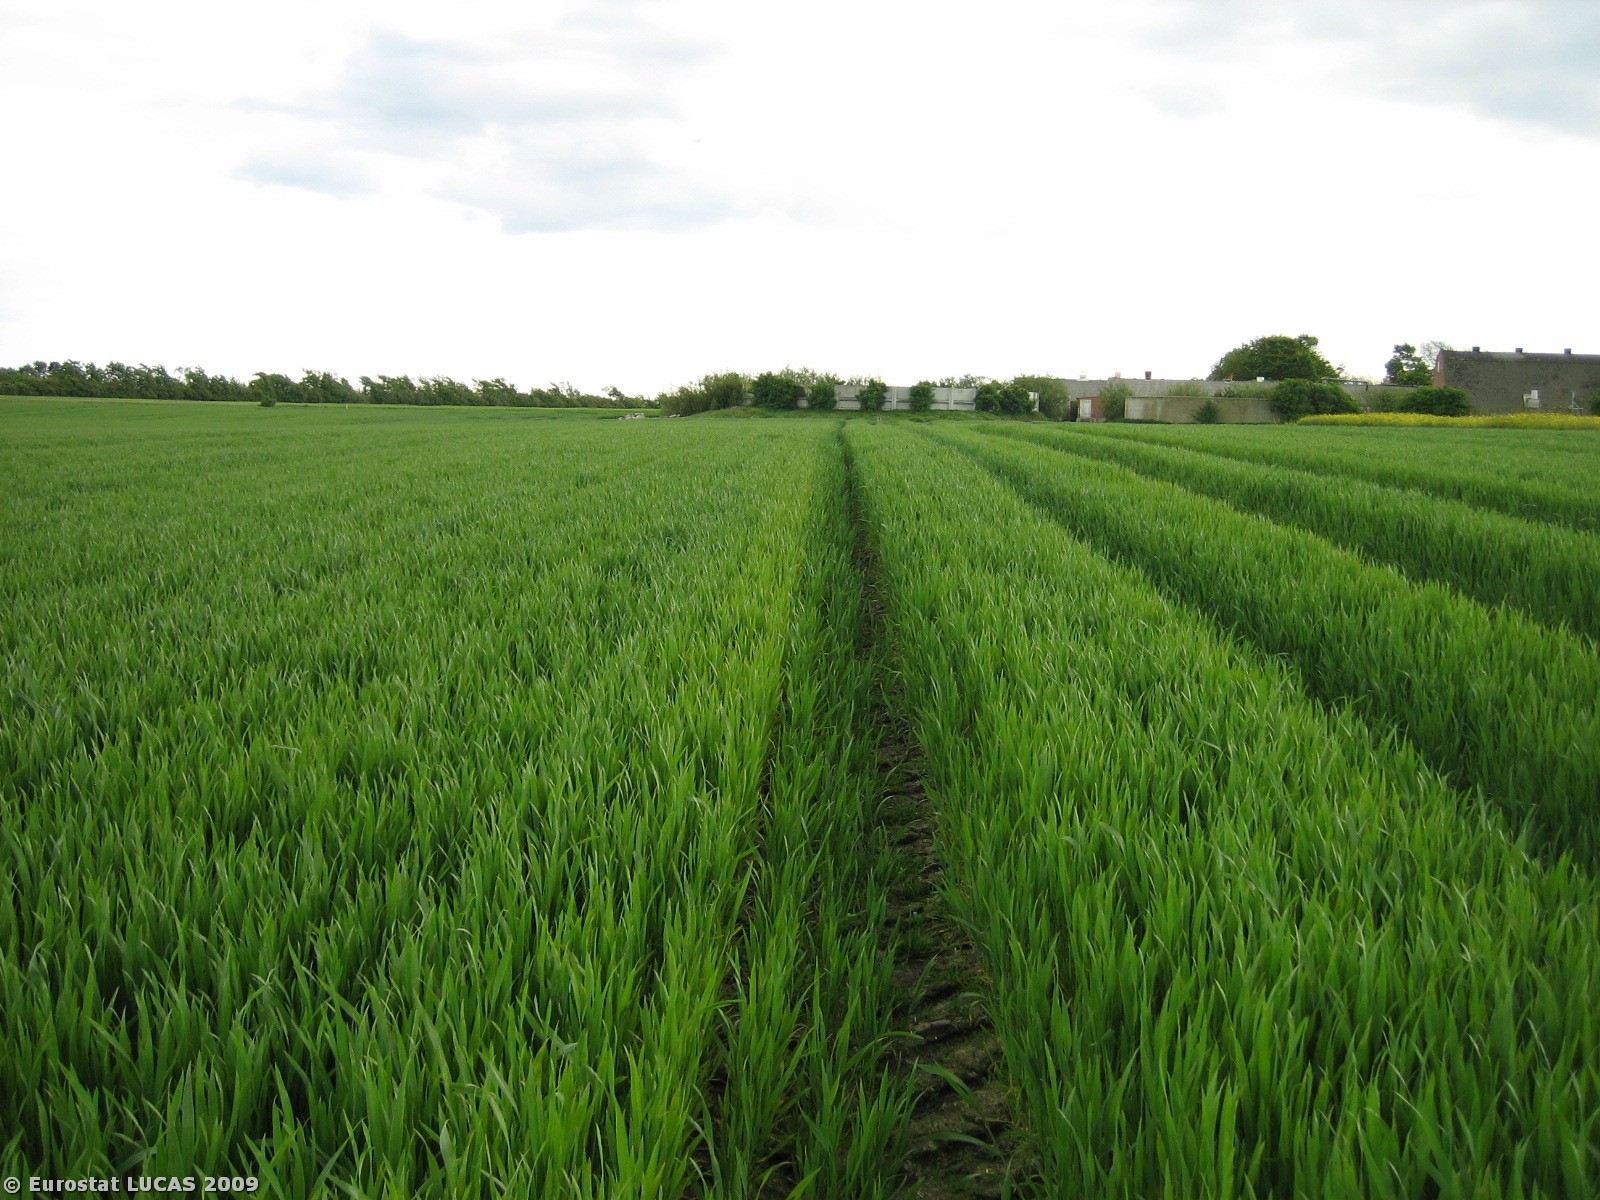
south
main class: Cropland
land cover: Common wheat
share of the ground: > 75 %
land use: Agriculture (excluding fallow land and kitchen gardens)
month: May
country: DK
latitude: 56.2113
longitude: 8.2123
